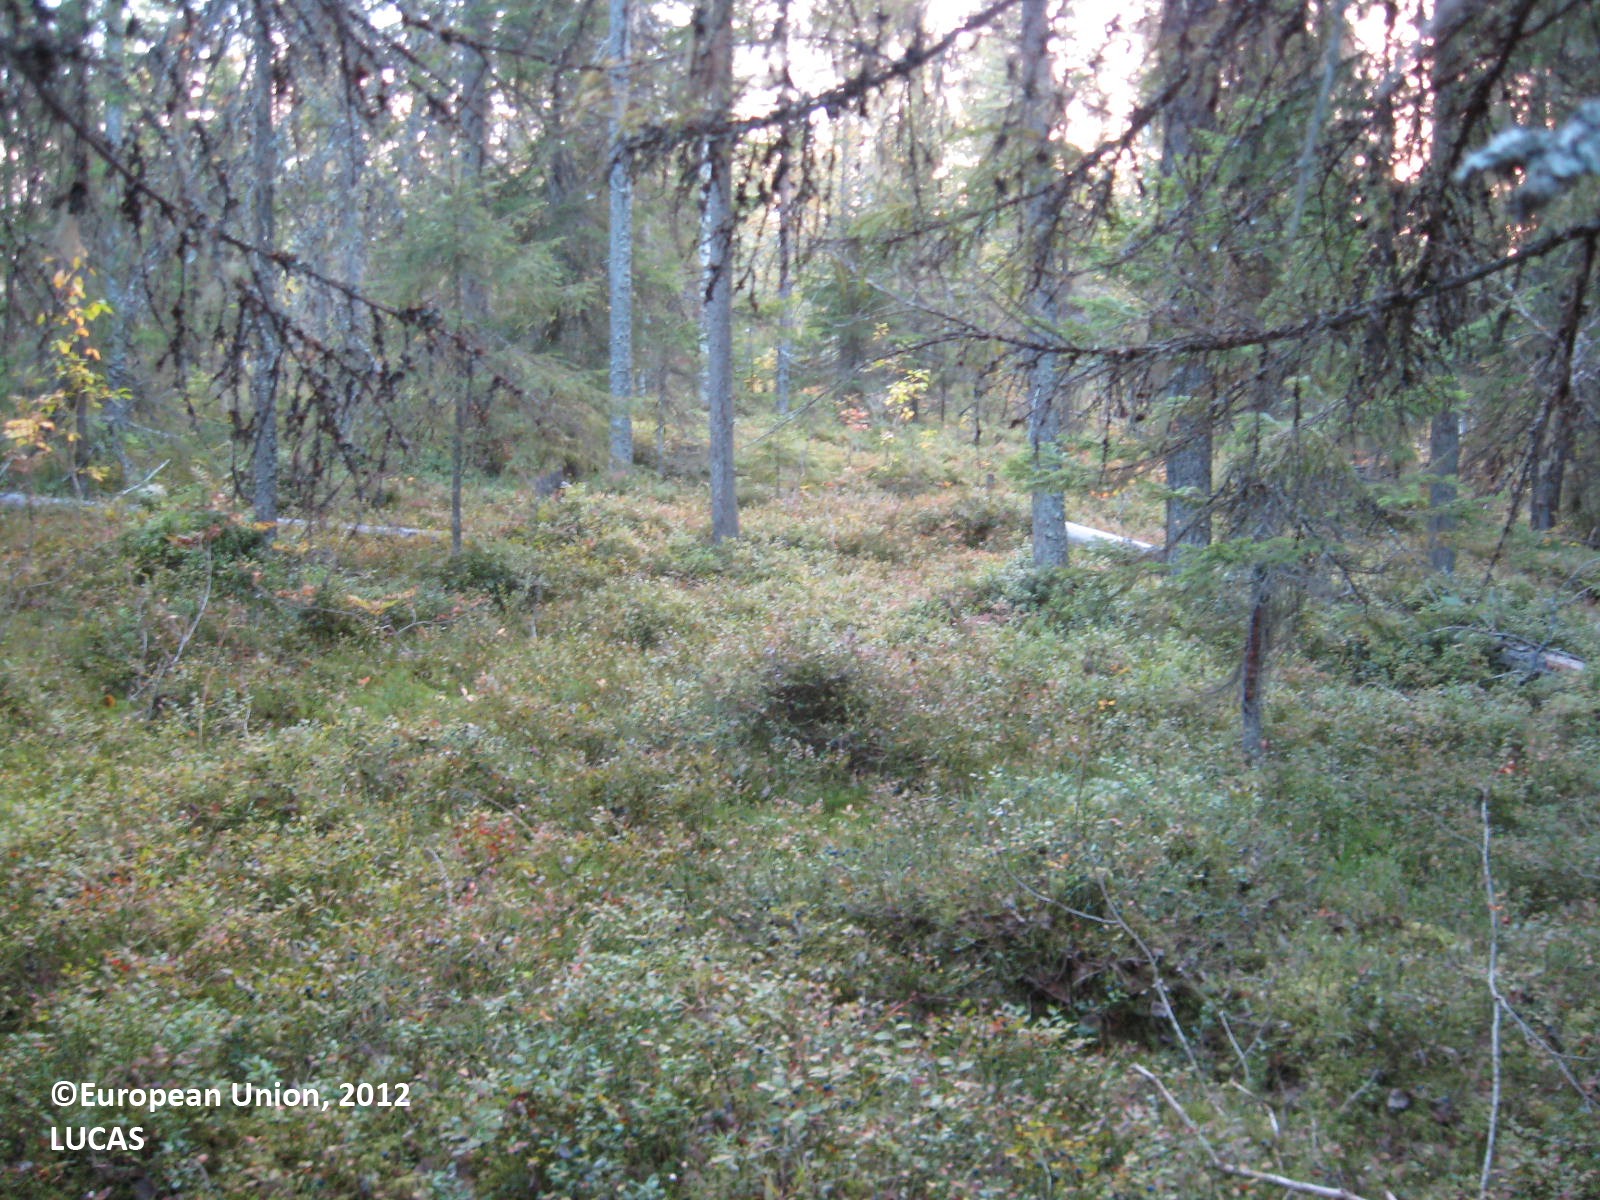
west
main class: Woodland
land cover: Other coniferous woodland
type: boreal forest
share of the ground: > 75 %
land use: Forestry
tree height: > 5 m
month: August
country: FI
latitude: 63.8789
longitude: 29.7982
